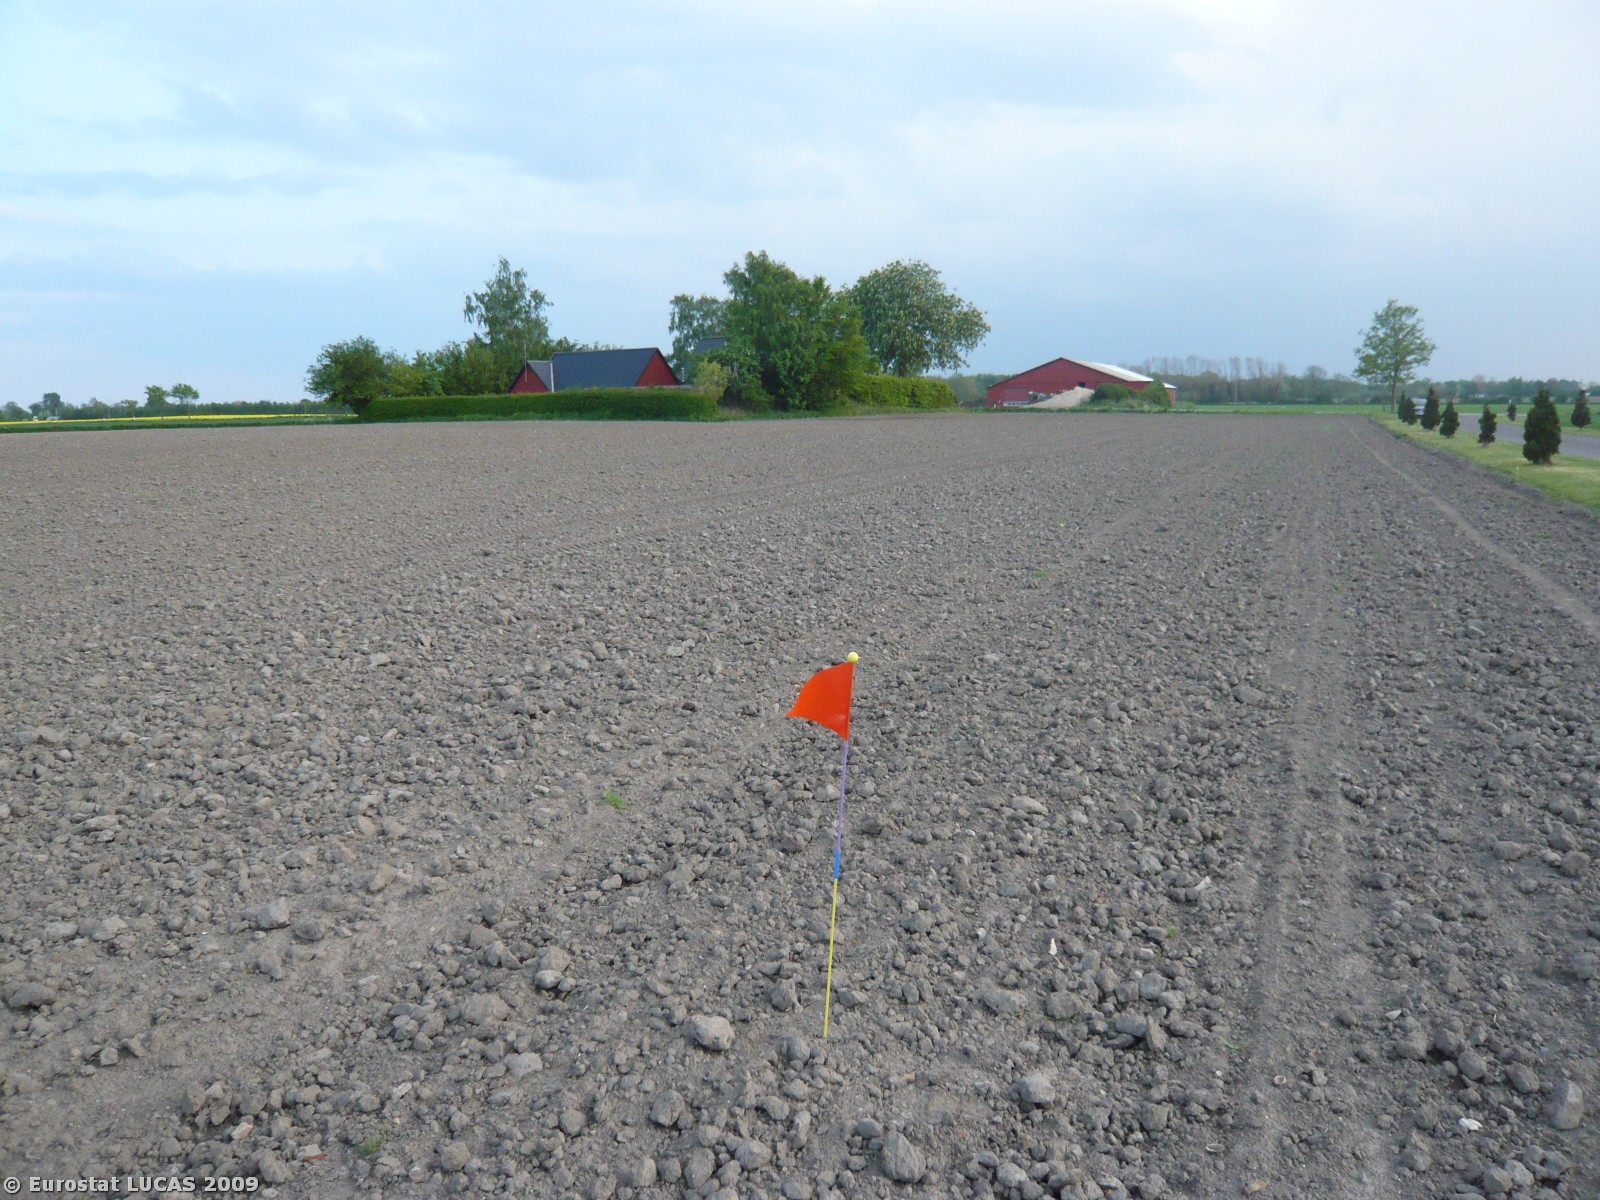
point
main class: Cropland
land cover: Other root crops
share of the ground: < 10 %
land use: Agriculture (excluding fallow land and kitchen gardens)
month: May
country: DK
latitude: 55.3223
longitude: 12.2835
